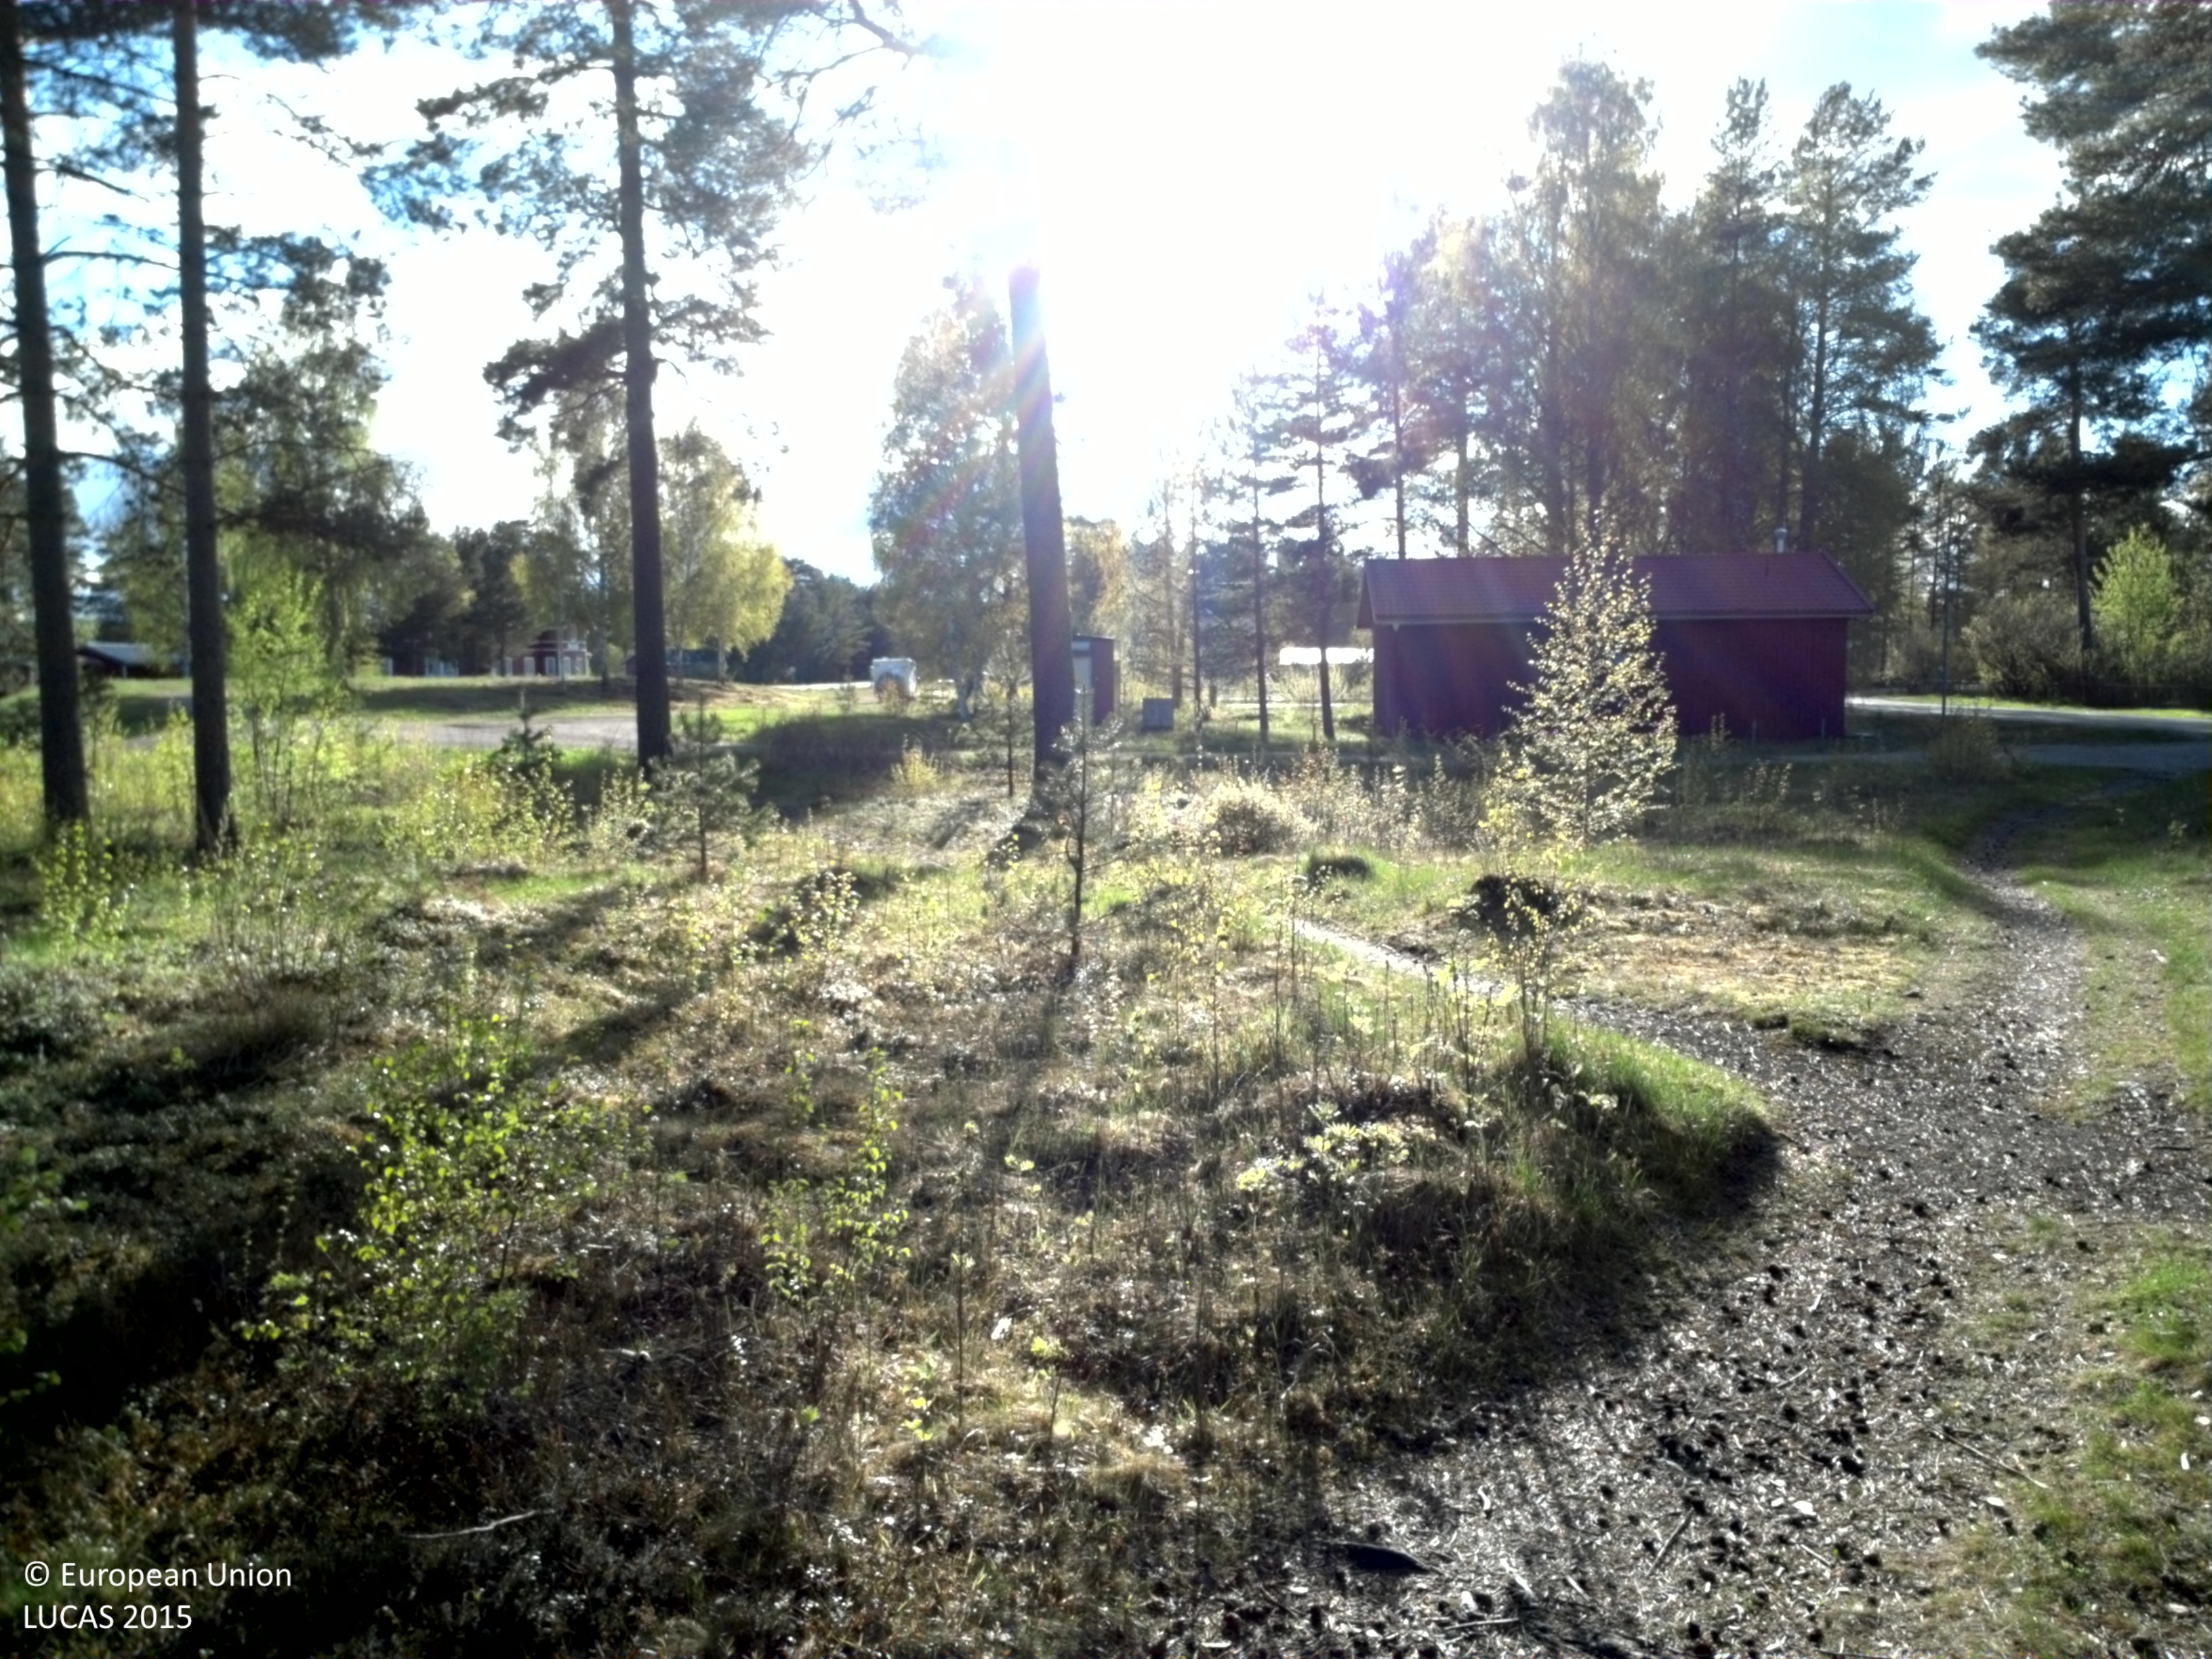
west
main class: Woodland
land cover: Pine dominated mixed woodland
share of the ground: 50 - 75 %
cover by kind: coniferous forest trees 50 %, broadleaved forest trees 20 %, shrubs 15 %, herbaceous plants 15 %
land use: Amenities, museums, leisure
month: May
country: SE
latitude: 61.1701
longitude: 15.1349
